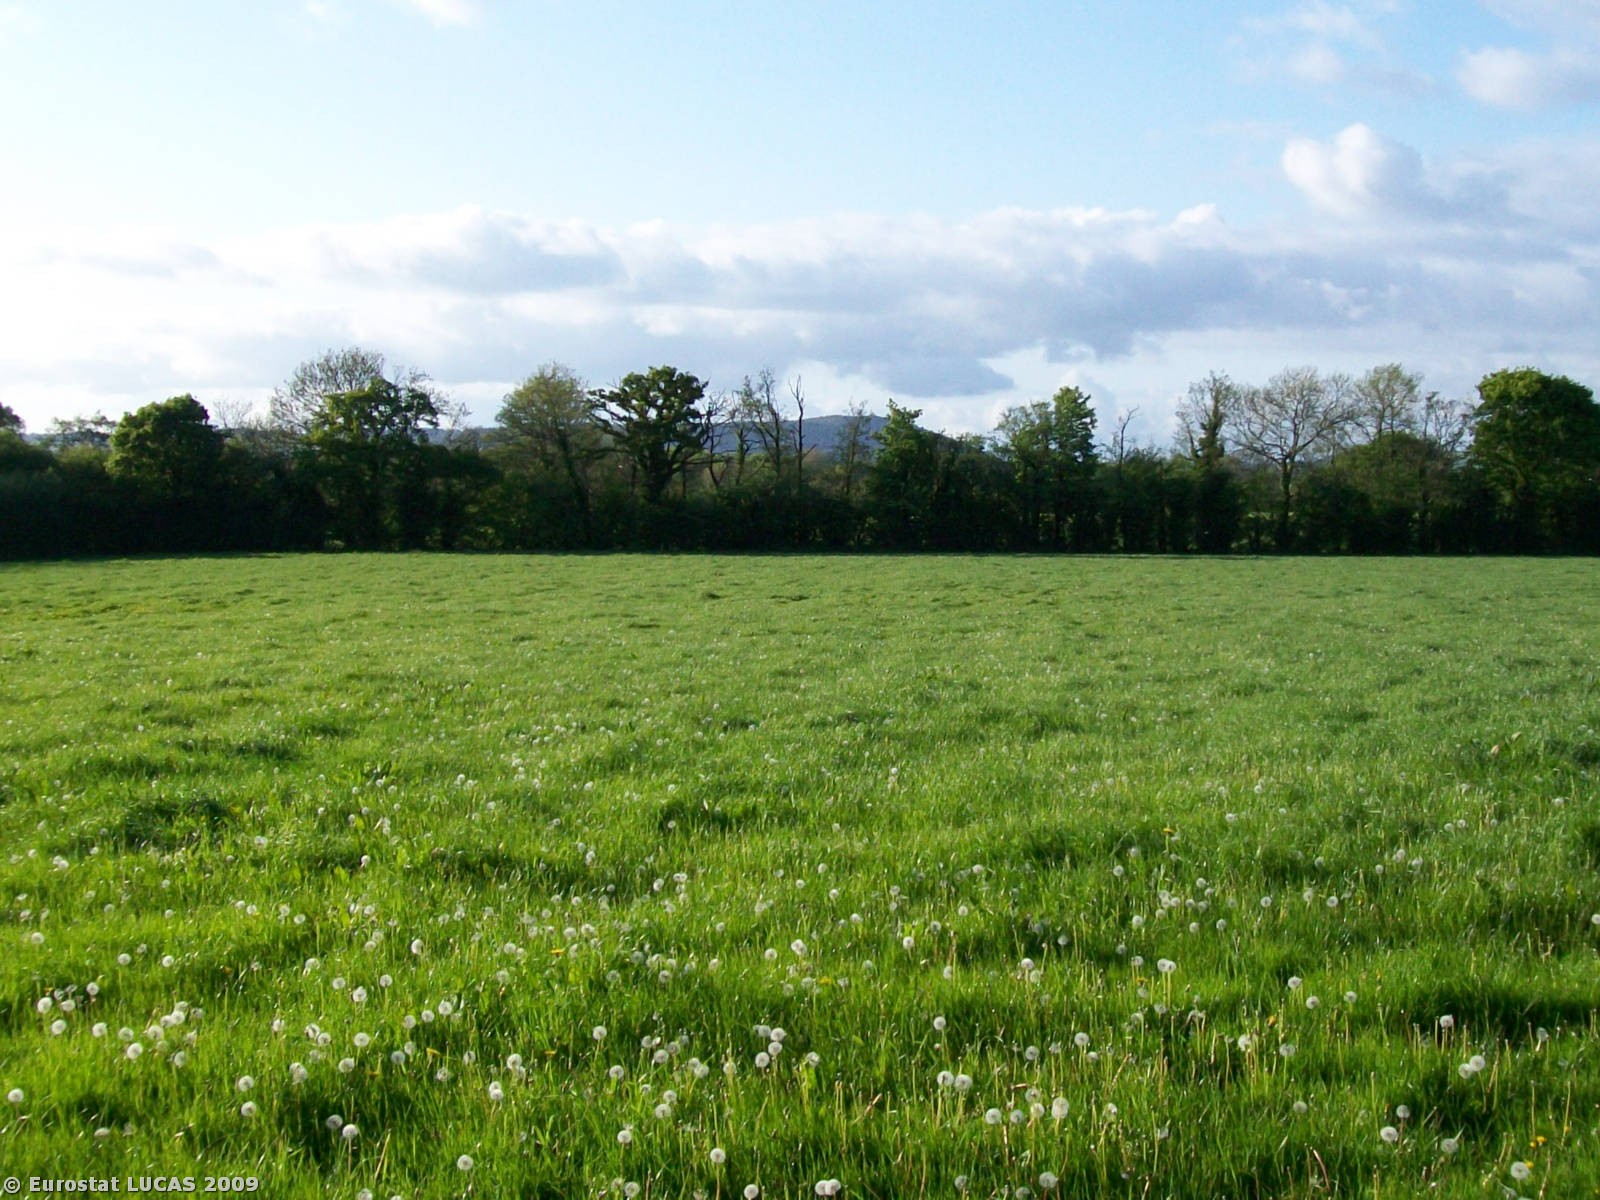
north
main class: Grassland
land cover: Grassland without tree/shrub cover
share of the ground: > 75 %
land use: Agriculture (excluding fallow land and kitchen gardens)
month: May
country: IE
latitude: 52.0692
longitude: -8.2603
